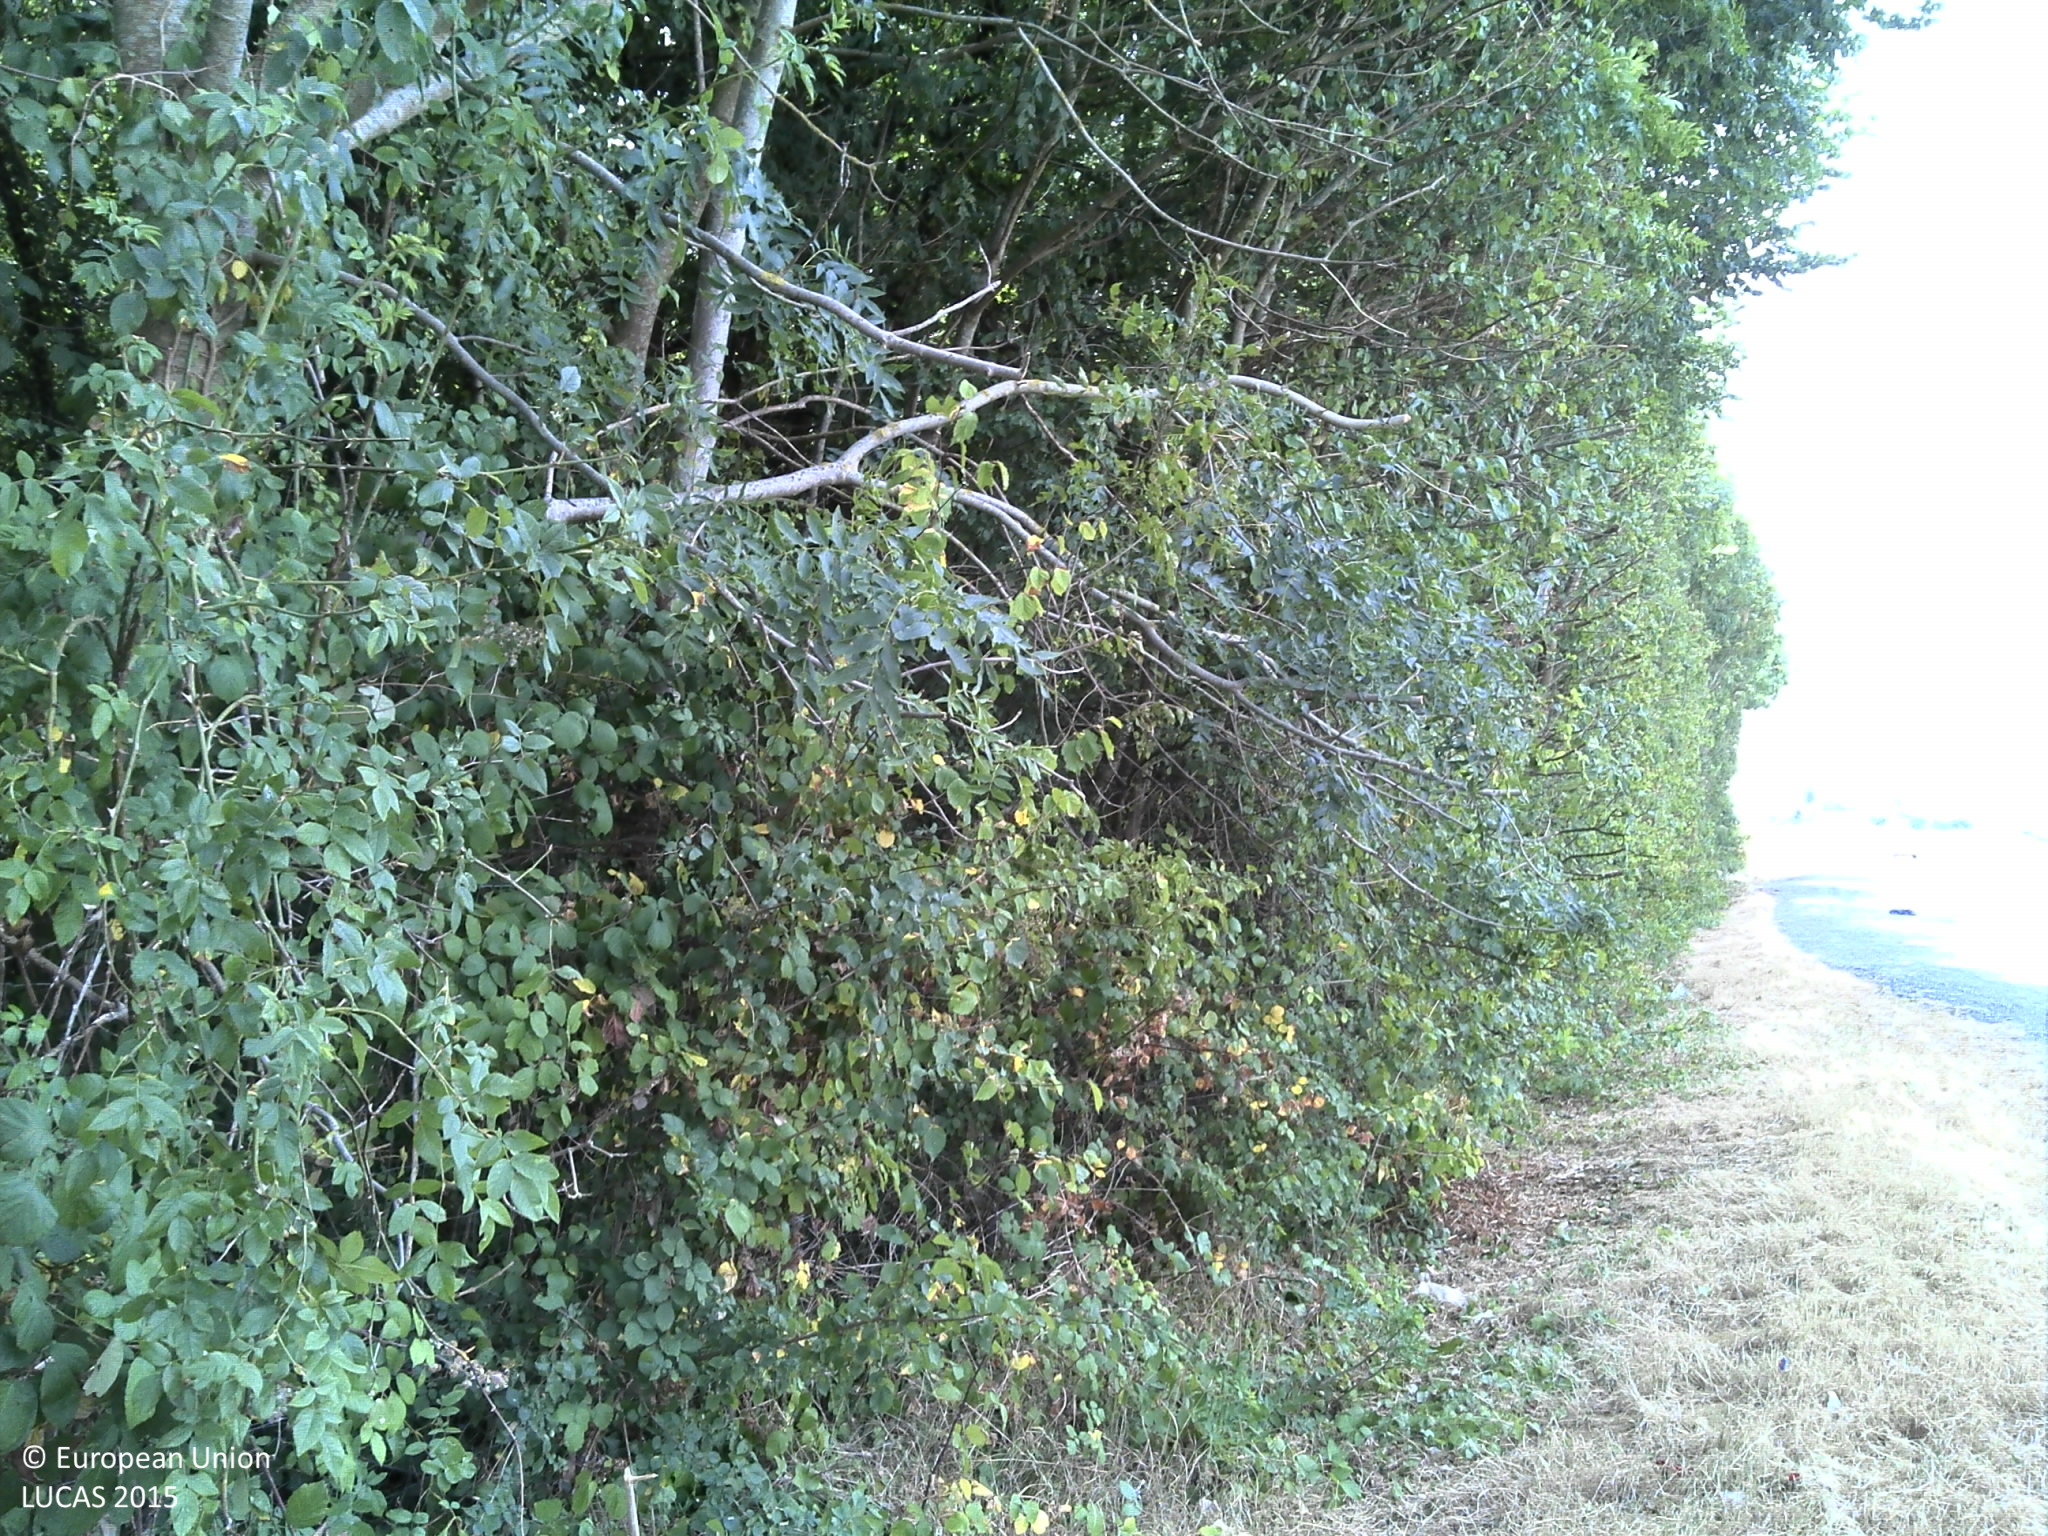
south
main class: Woodland
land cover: Broadleaved woodland
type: beech forest
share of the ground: > 75 %
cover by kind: broadleaved forest trees 100 %
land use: Forestry
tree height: > 5 m
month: July
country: FR
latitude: 48.5763
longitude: 2.4120
